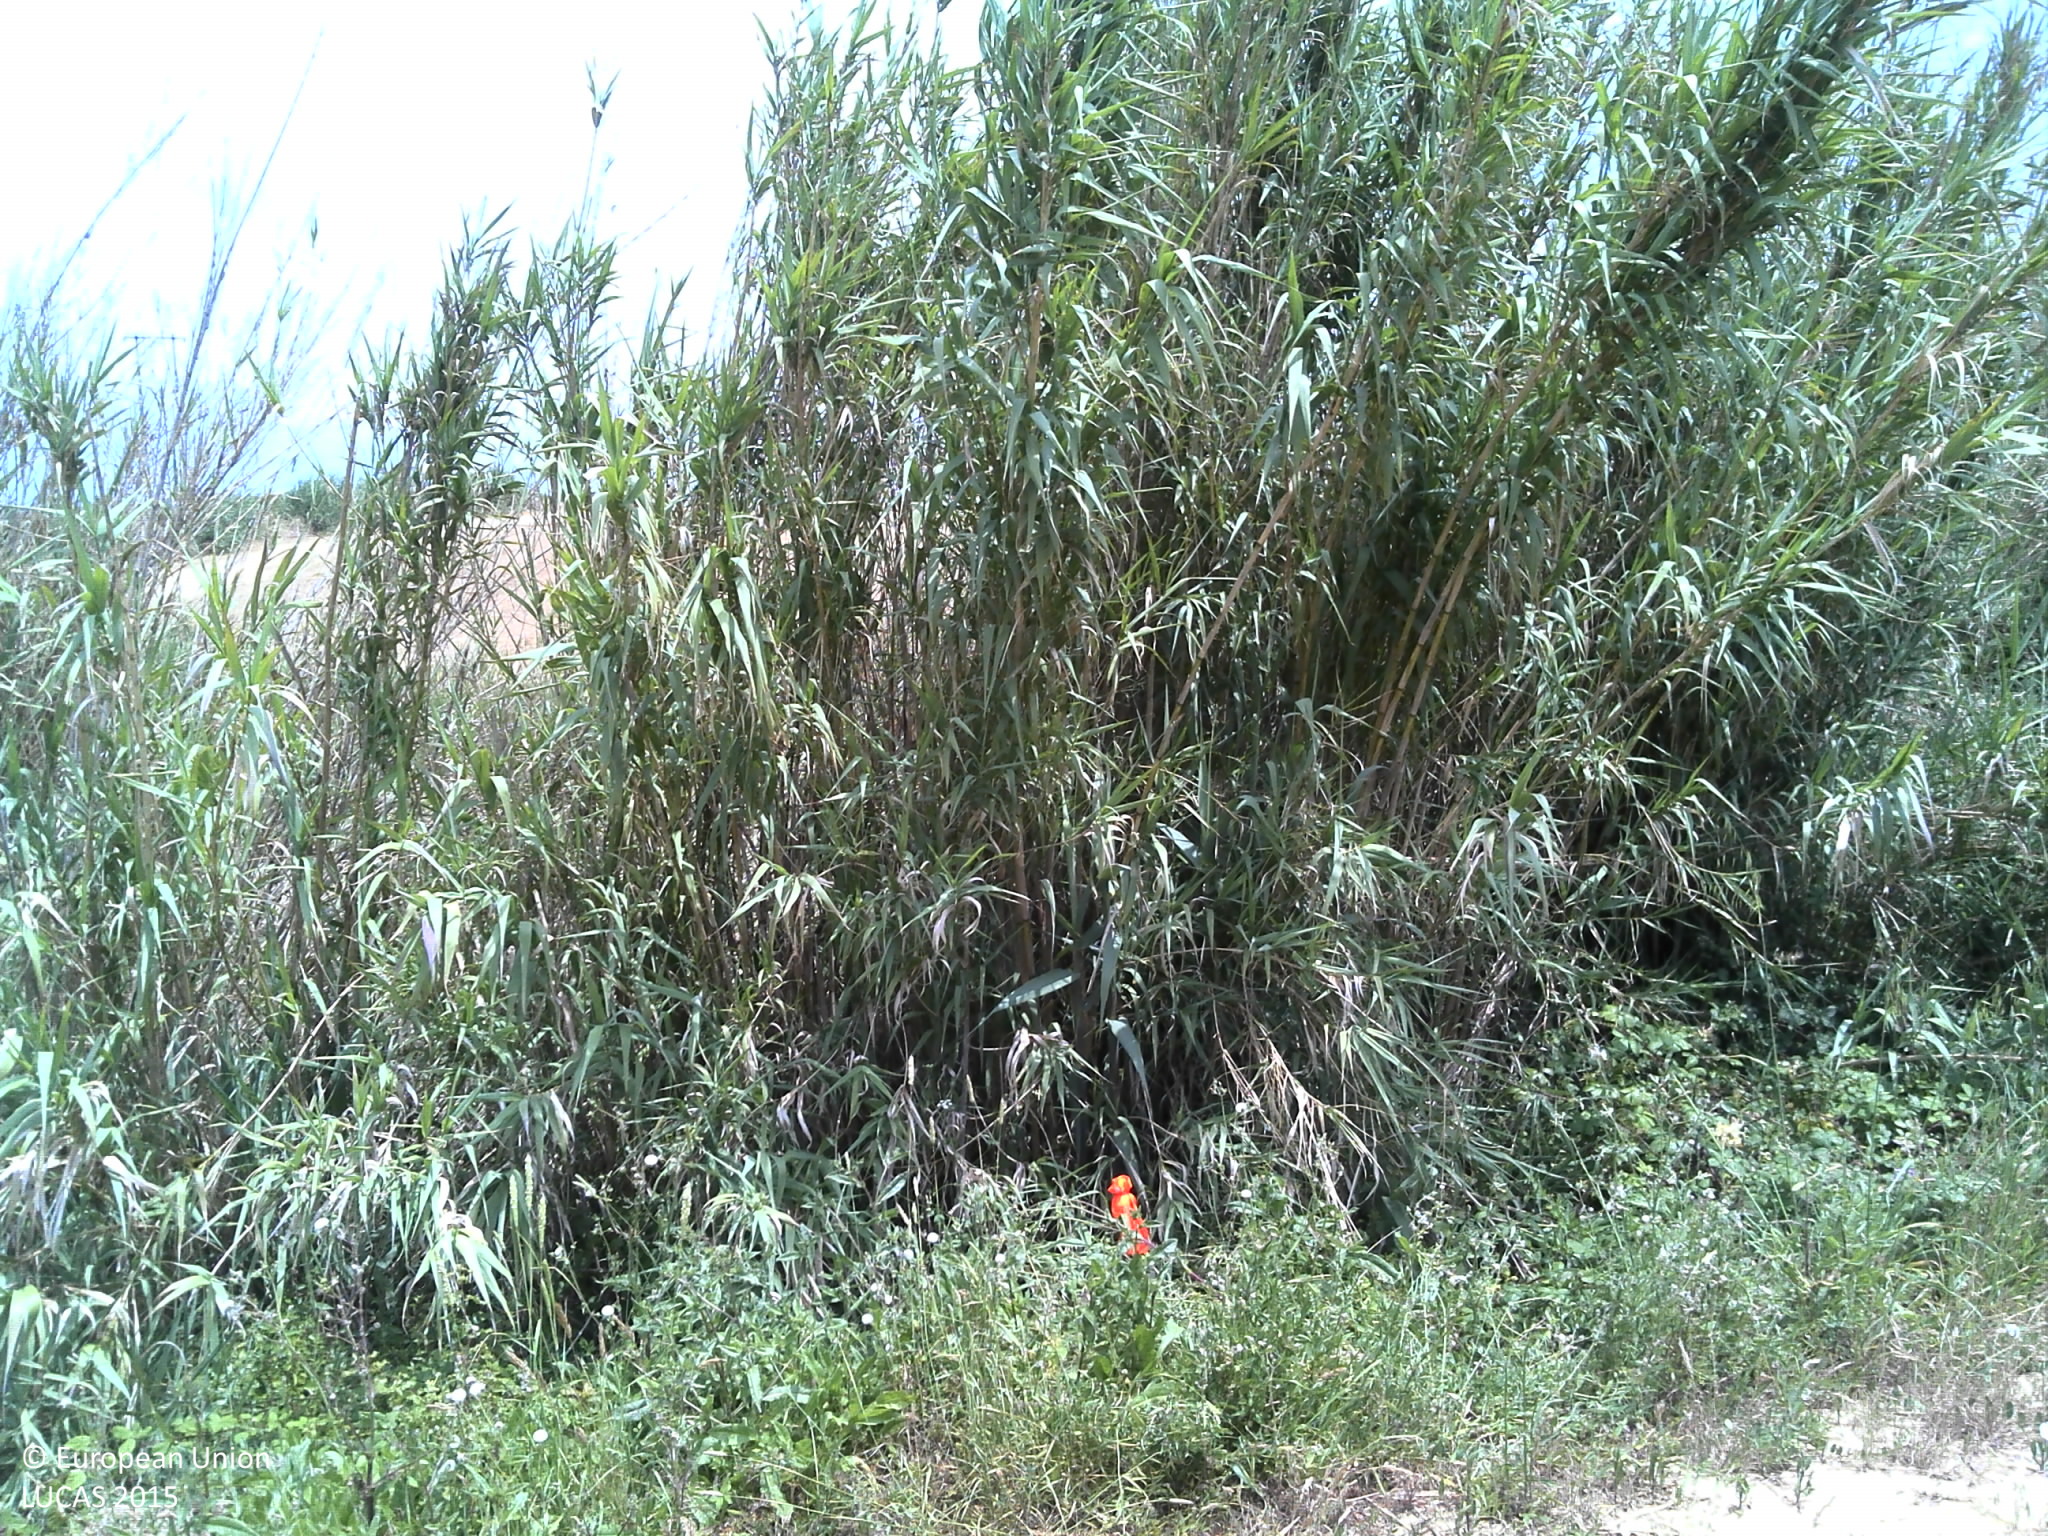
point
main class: Shrubland
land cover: Shrubland without tree cover
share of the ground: > 75 %
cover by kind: shrubs 60 %, unconsolidated bare surface 30 %, herbaceous plants 10 %
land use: Semi-natural and natural areas not in use
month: June
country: PT
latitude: 39.3284
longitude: -9.3148
